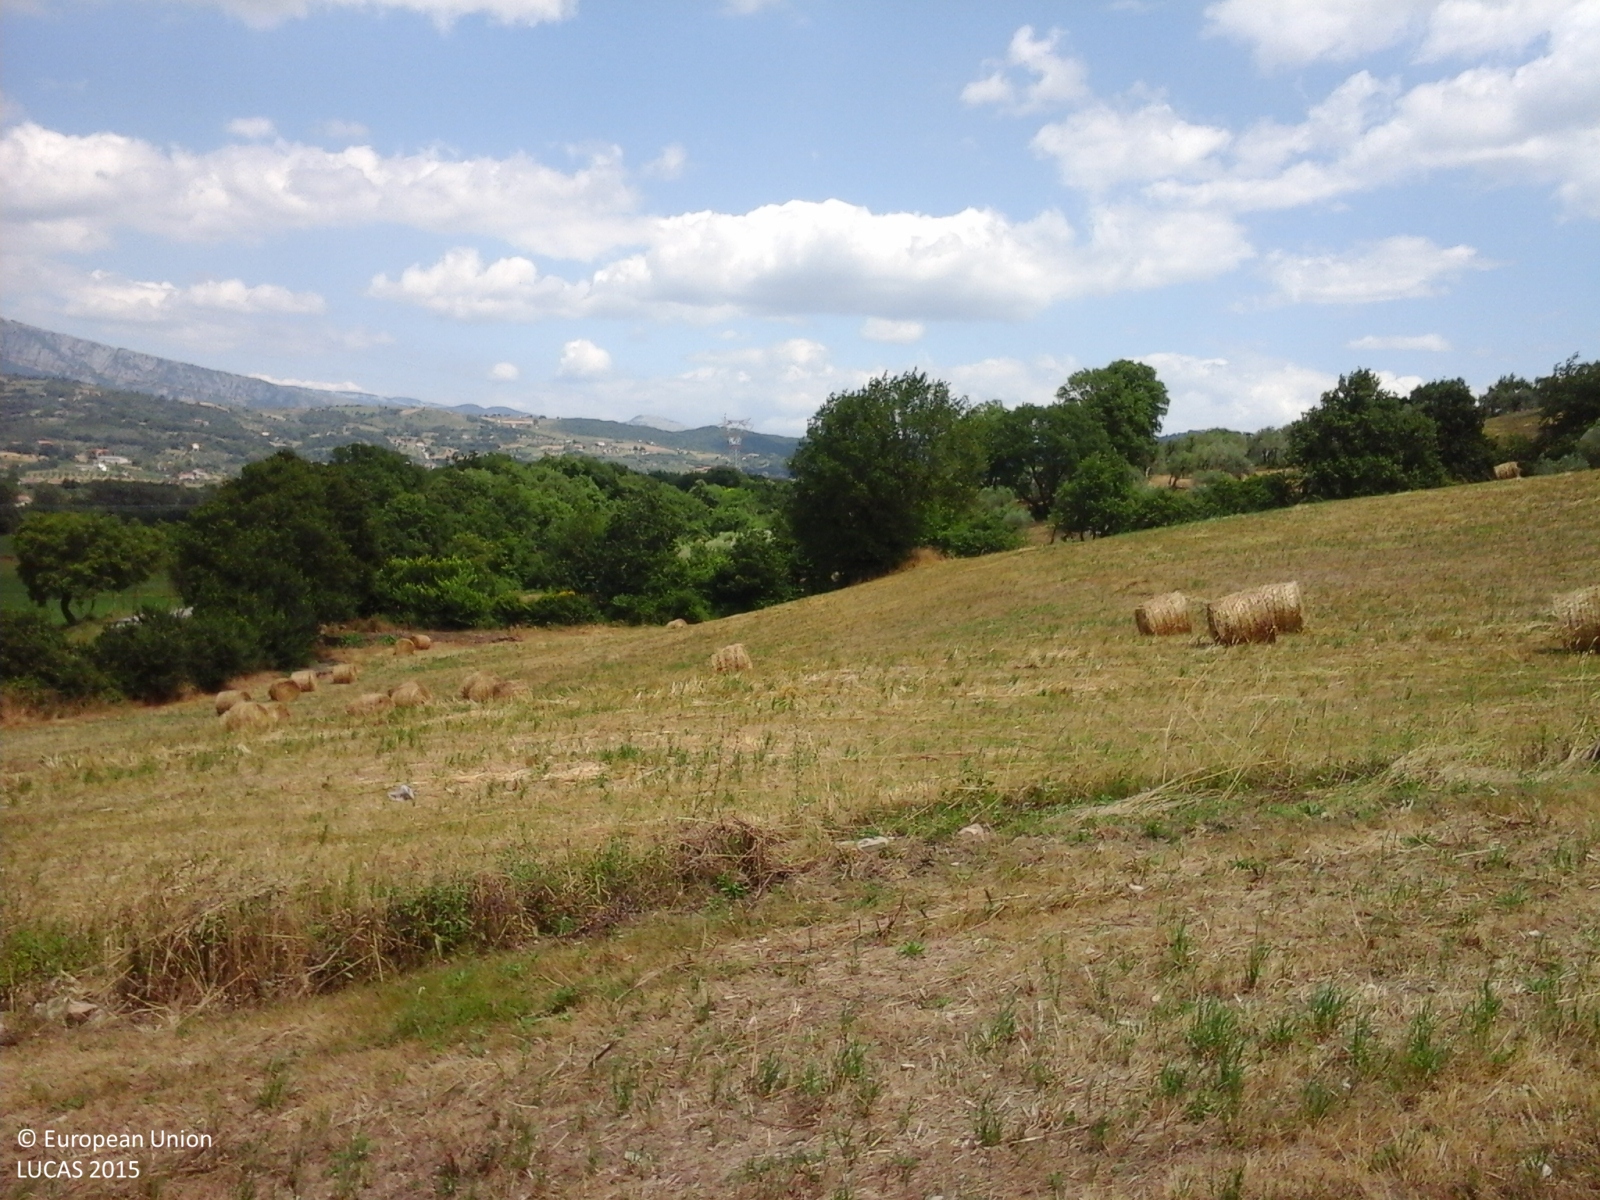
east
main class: Cropland
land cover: Temporary grasslands
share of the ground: > 75 %
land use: Agriculture (excluding fallow land and kitchen gardens)
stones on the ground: 10 - 25 %
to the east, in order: Temporary grasslands; Shrubland with sparse tree cover; Tracks; Grassland with sparse tree/shrub cover; Broadleaved woodland
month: June
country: IT
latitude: 40.4967
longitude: 15.1111
